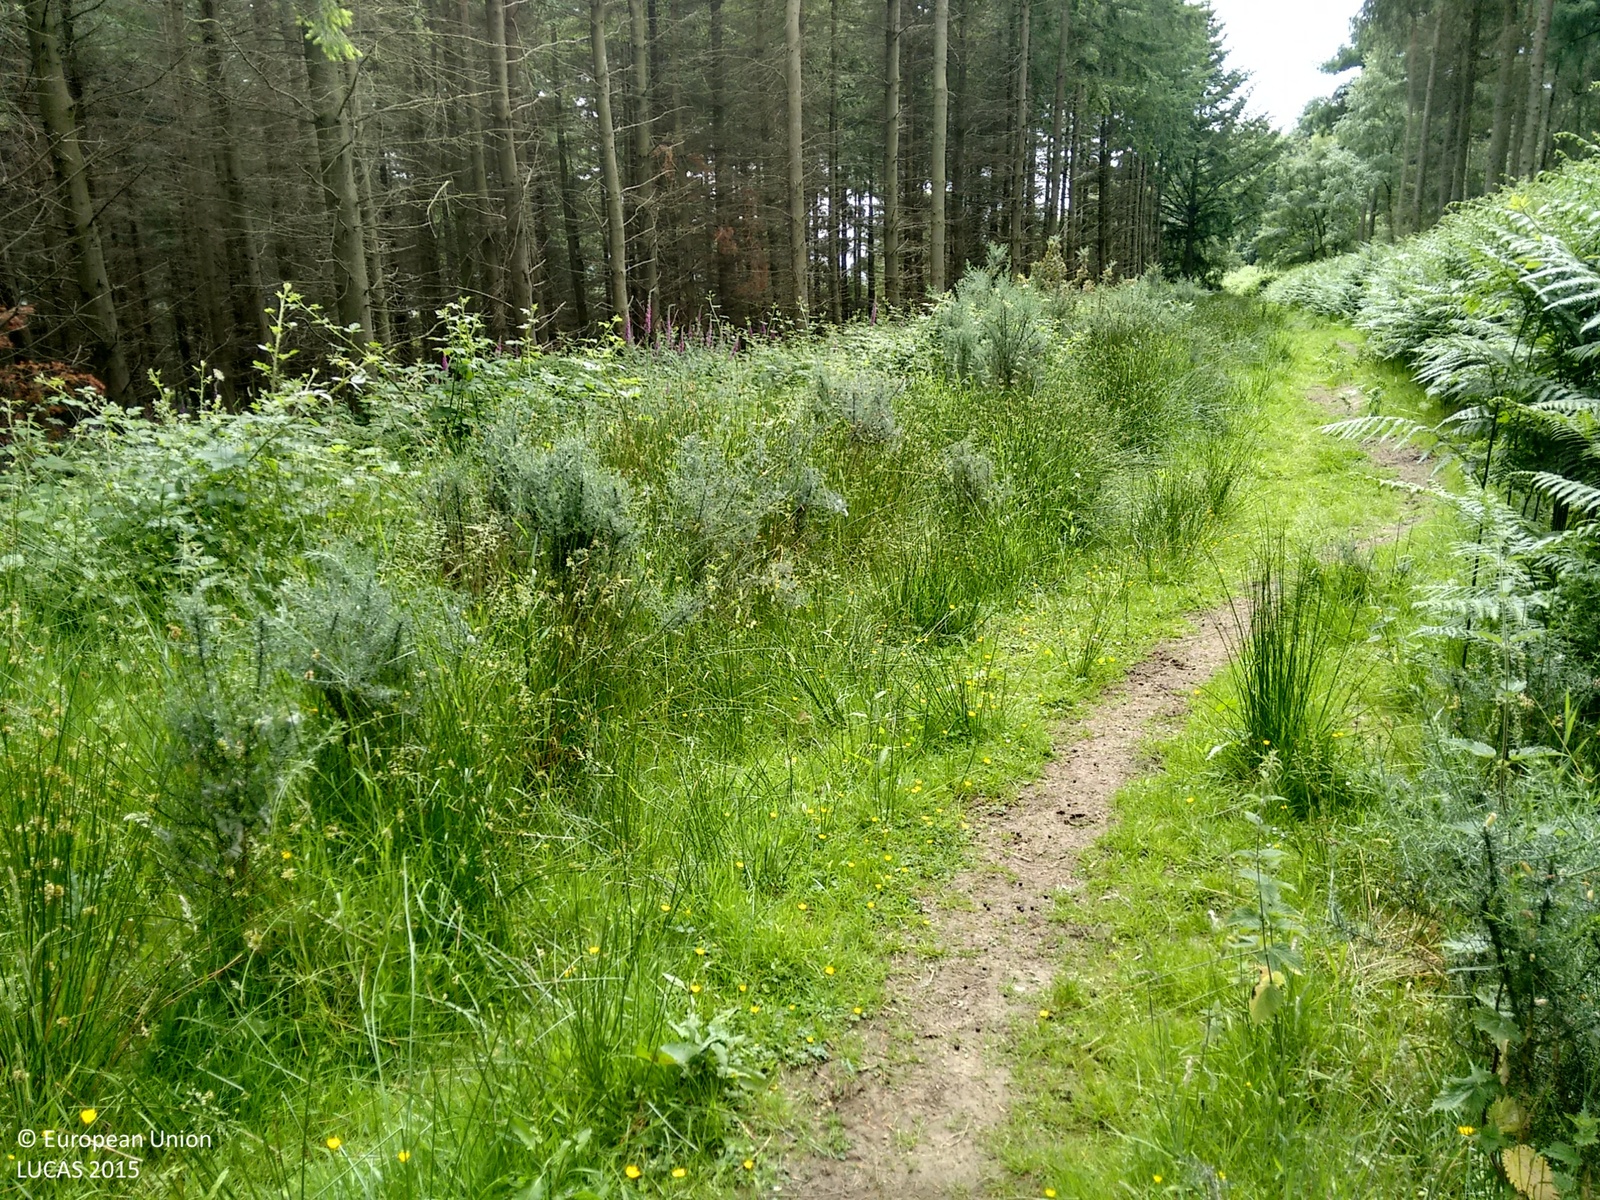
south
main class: Woodland
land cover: Spruce dominated coniferous woodland
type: exotic forest
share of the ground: > 75 %
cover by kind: coniferous forest trees 95 %, shrubs 5 %
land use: Forestry
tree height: > 5 m
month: June
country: GB
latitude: 52.3017
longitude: -2.7856
